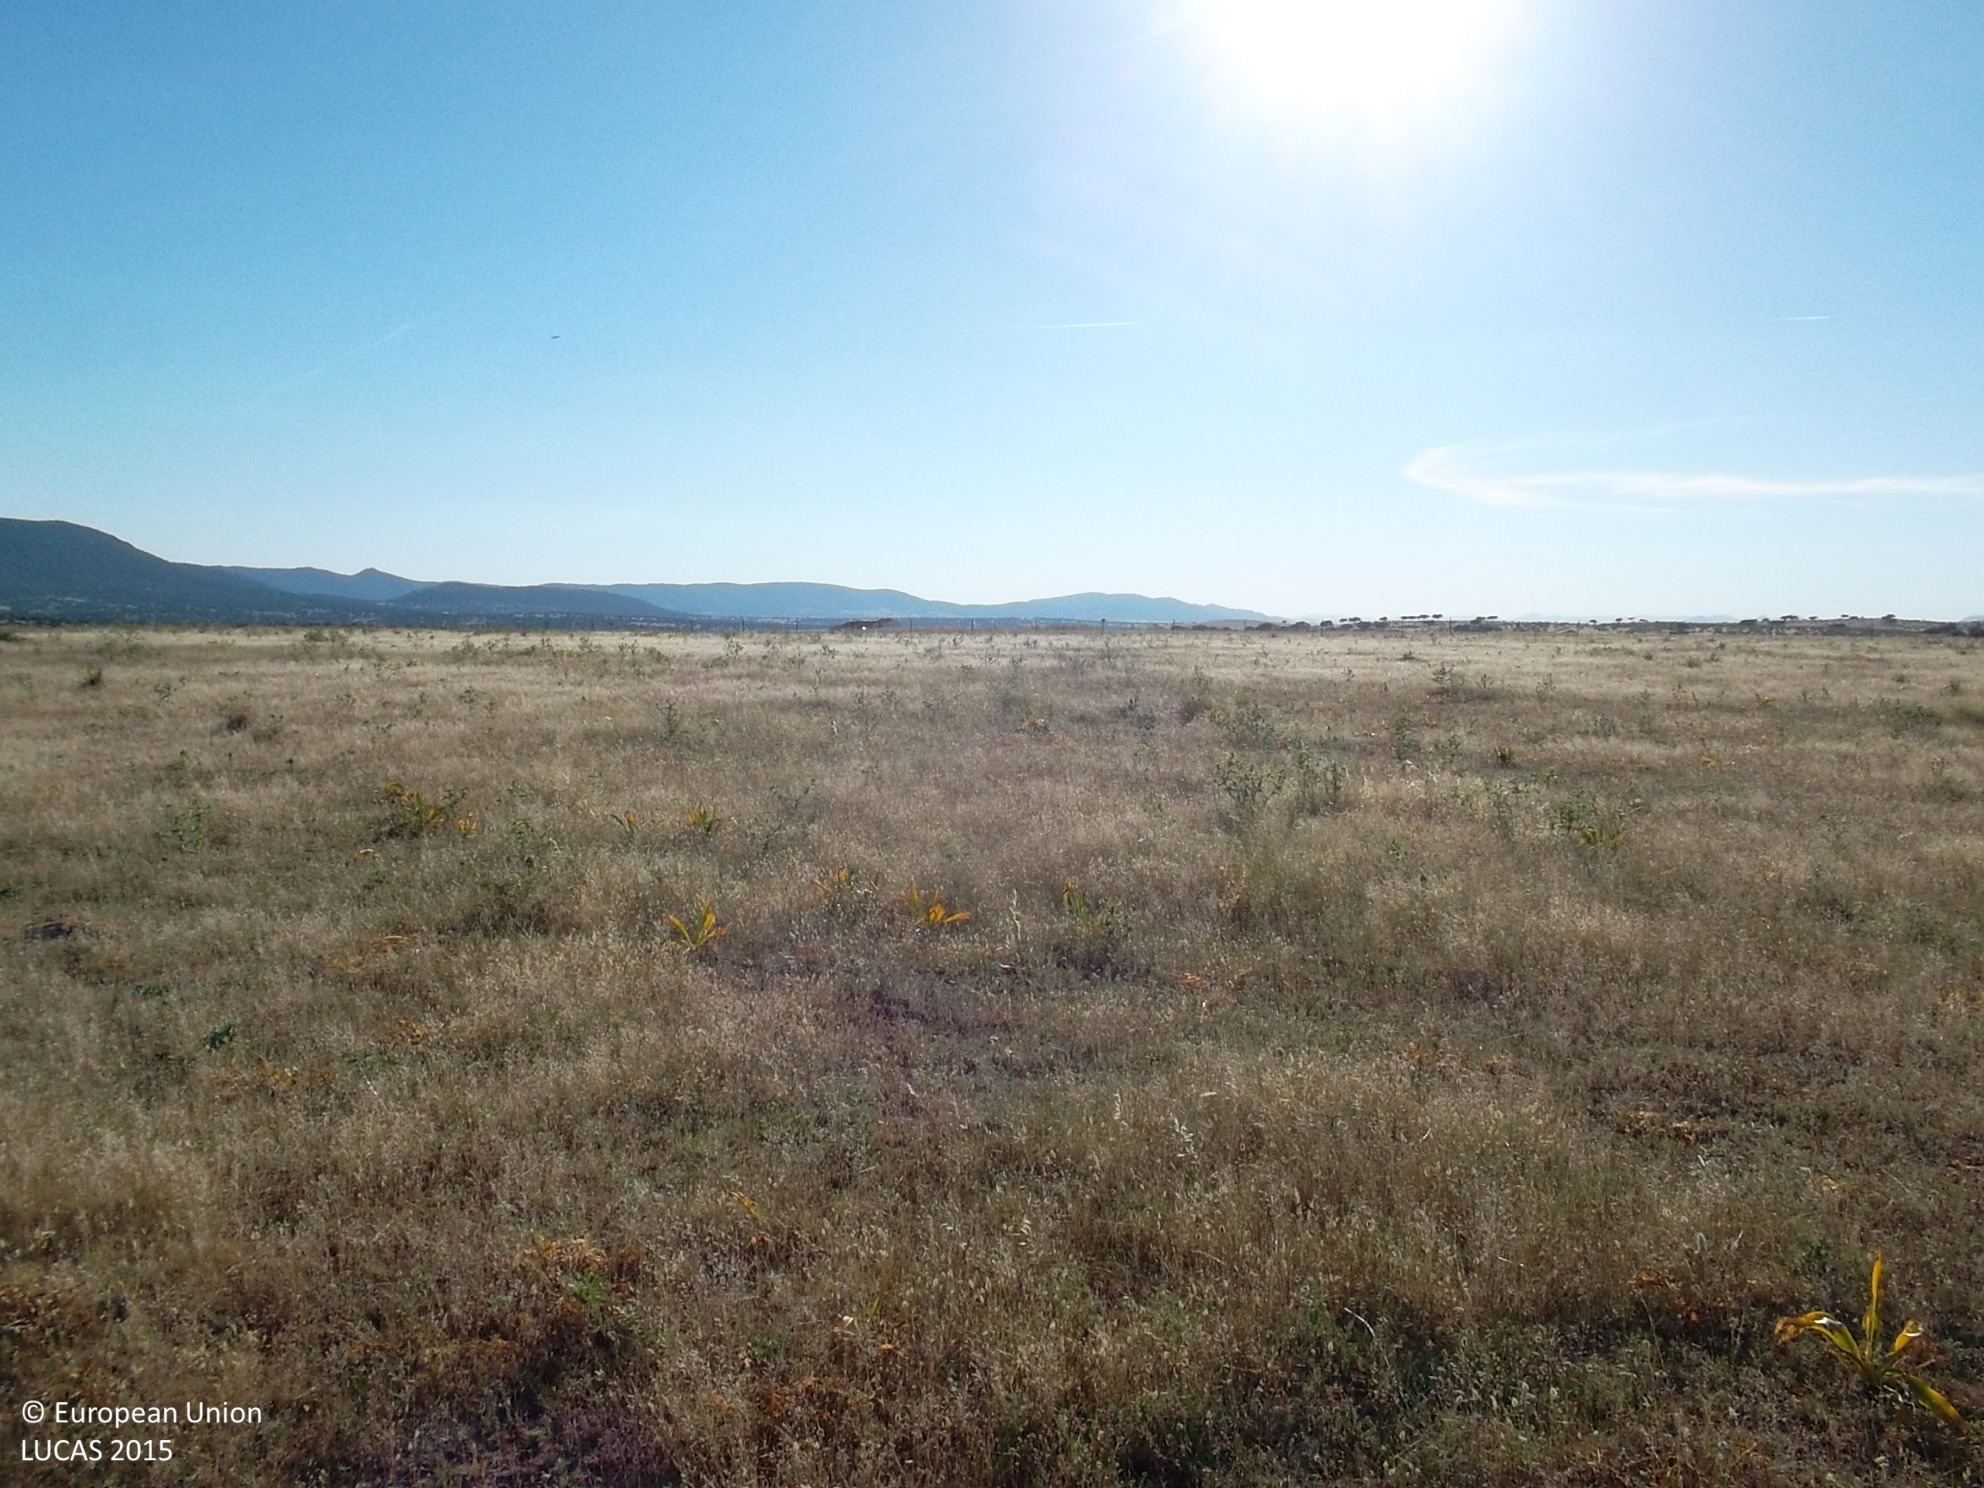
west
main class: Grassland
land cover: Grassland without tree/shrub cover
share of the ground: > 75 %
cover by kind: herbaceous plants 95 %, shrubs 5 %
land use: Agriculture (excluding fallow land and kitchen gardens)
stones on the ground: < 10 %
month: May
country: ES
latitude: 38.6174
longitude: -4.4818
